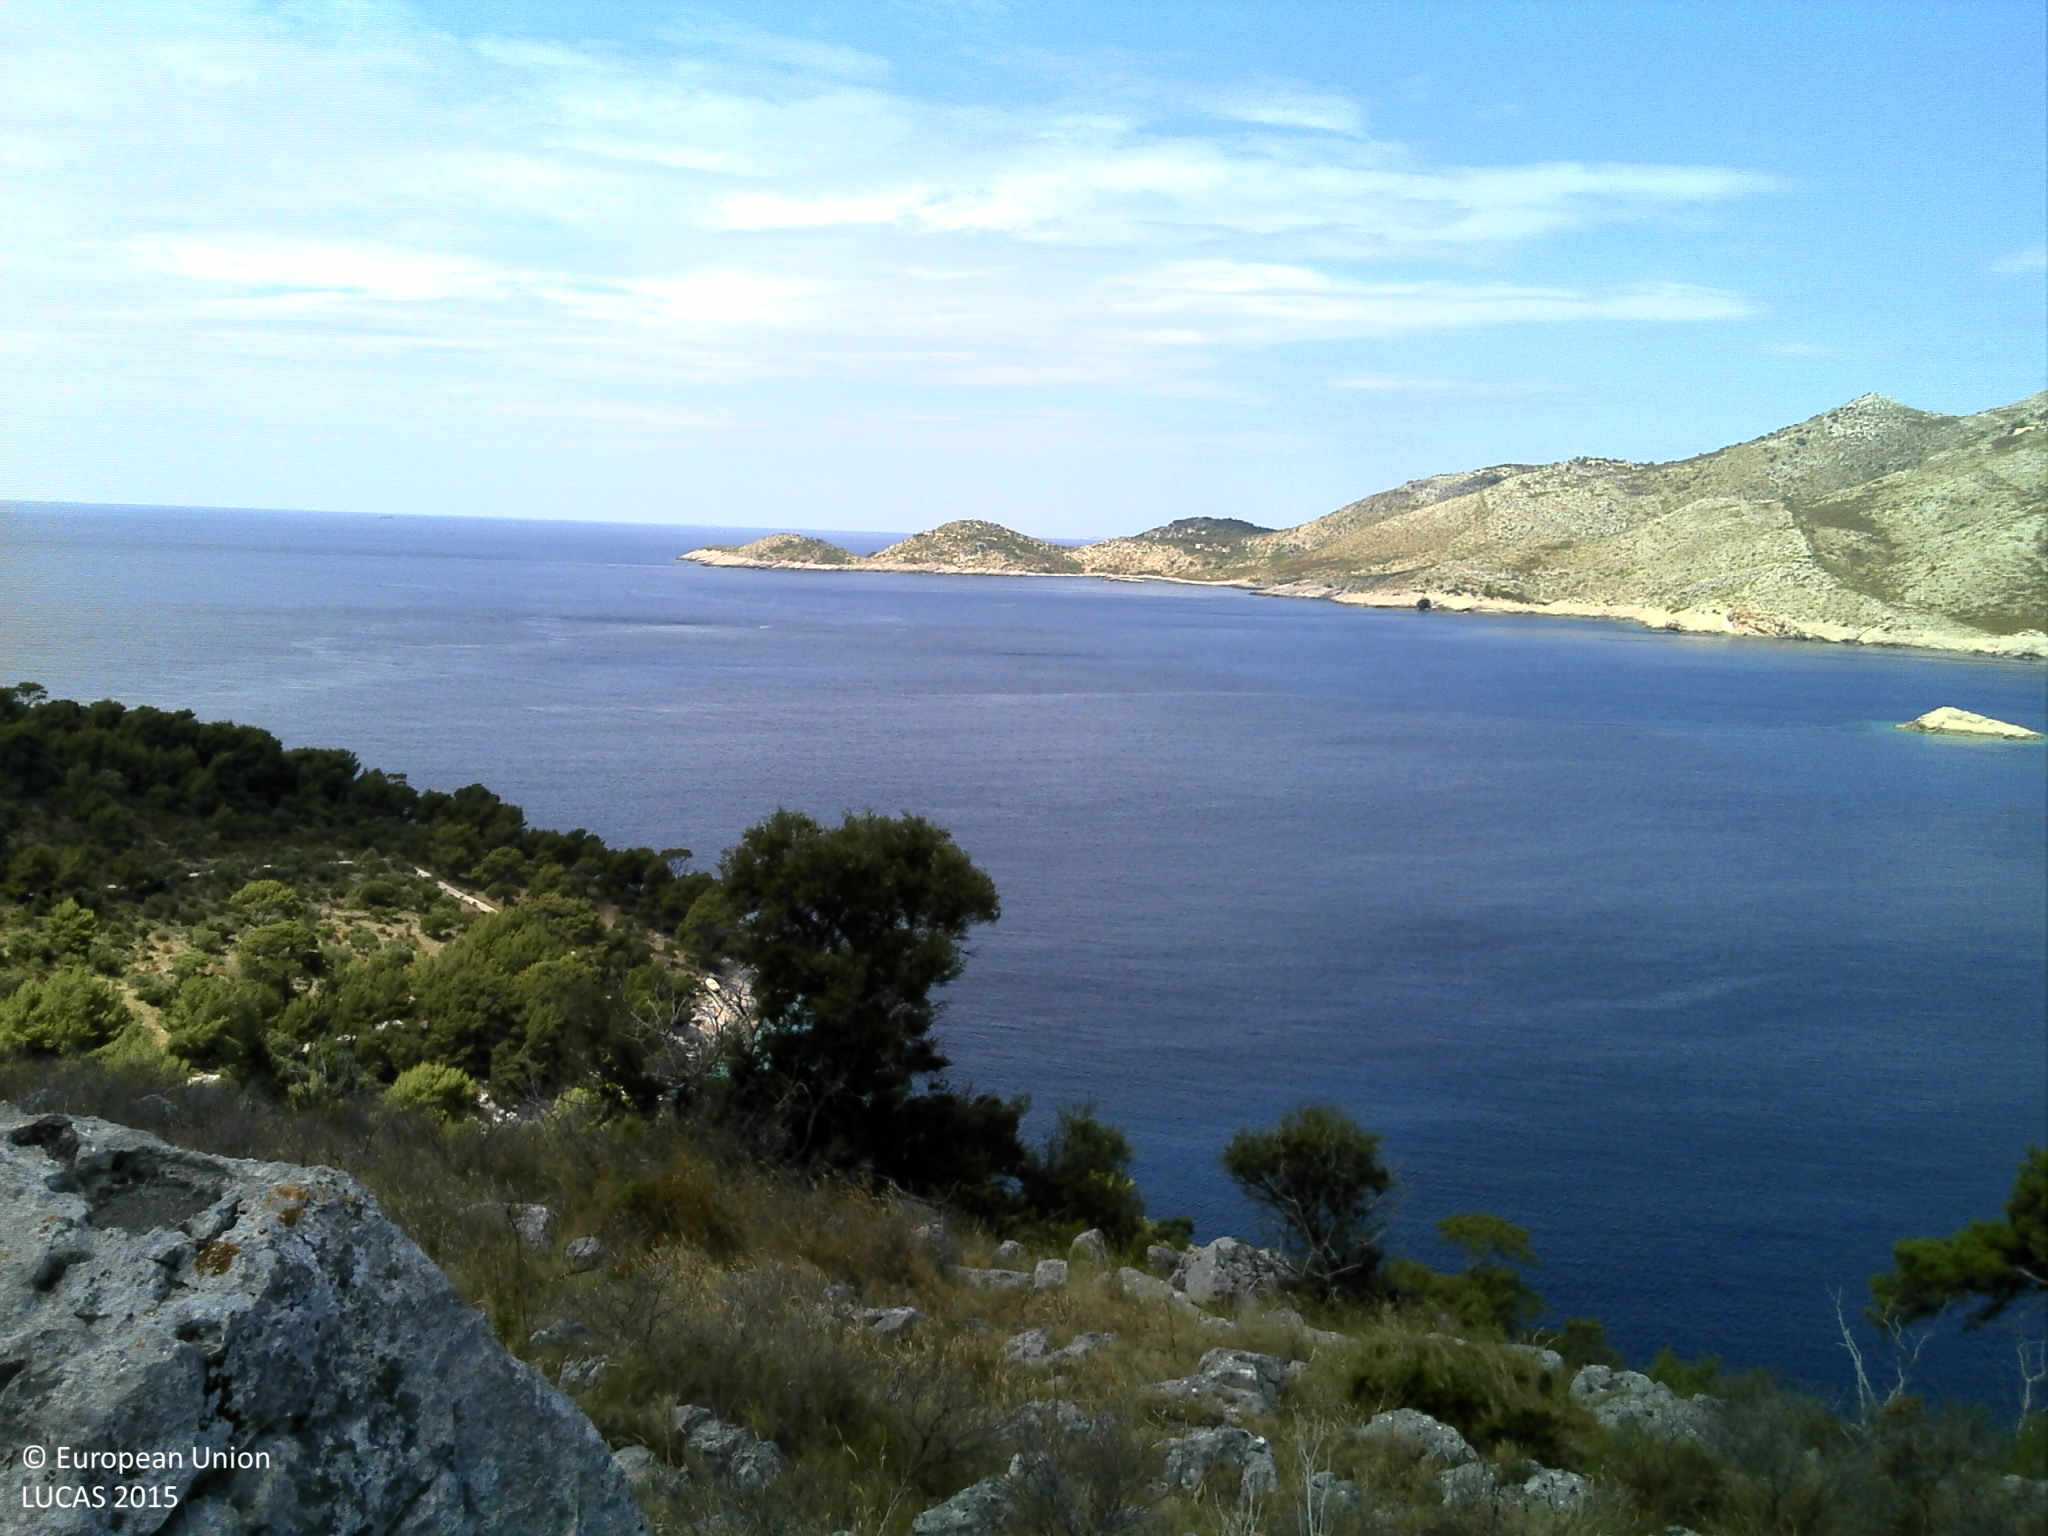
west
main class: Shrubland
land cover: Shrubland without tree cover
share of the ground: 10 - 25 %
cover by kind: herbaceous plants 30 %, unconsolidated bare surface 30 %, shrubs 20 %, consolidated bare surface 15 %, lichens and mosses 5 %
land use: Semi-natural and natural areas not in use
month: June
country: HR
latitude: 42.7274
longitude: 16.8882
